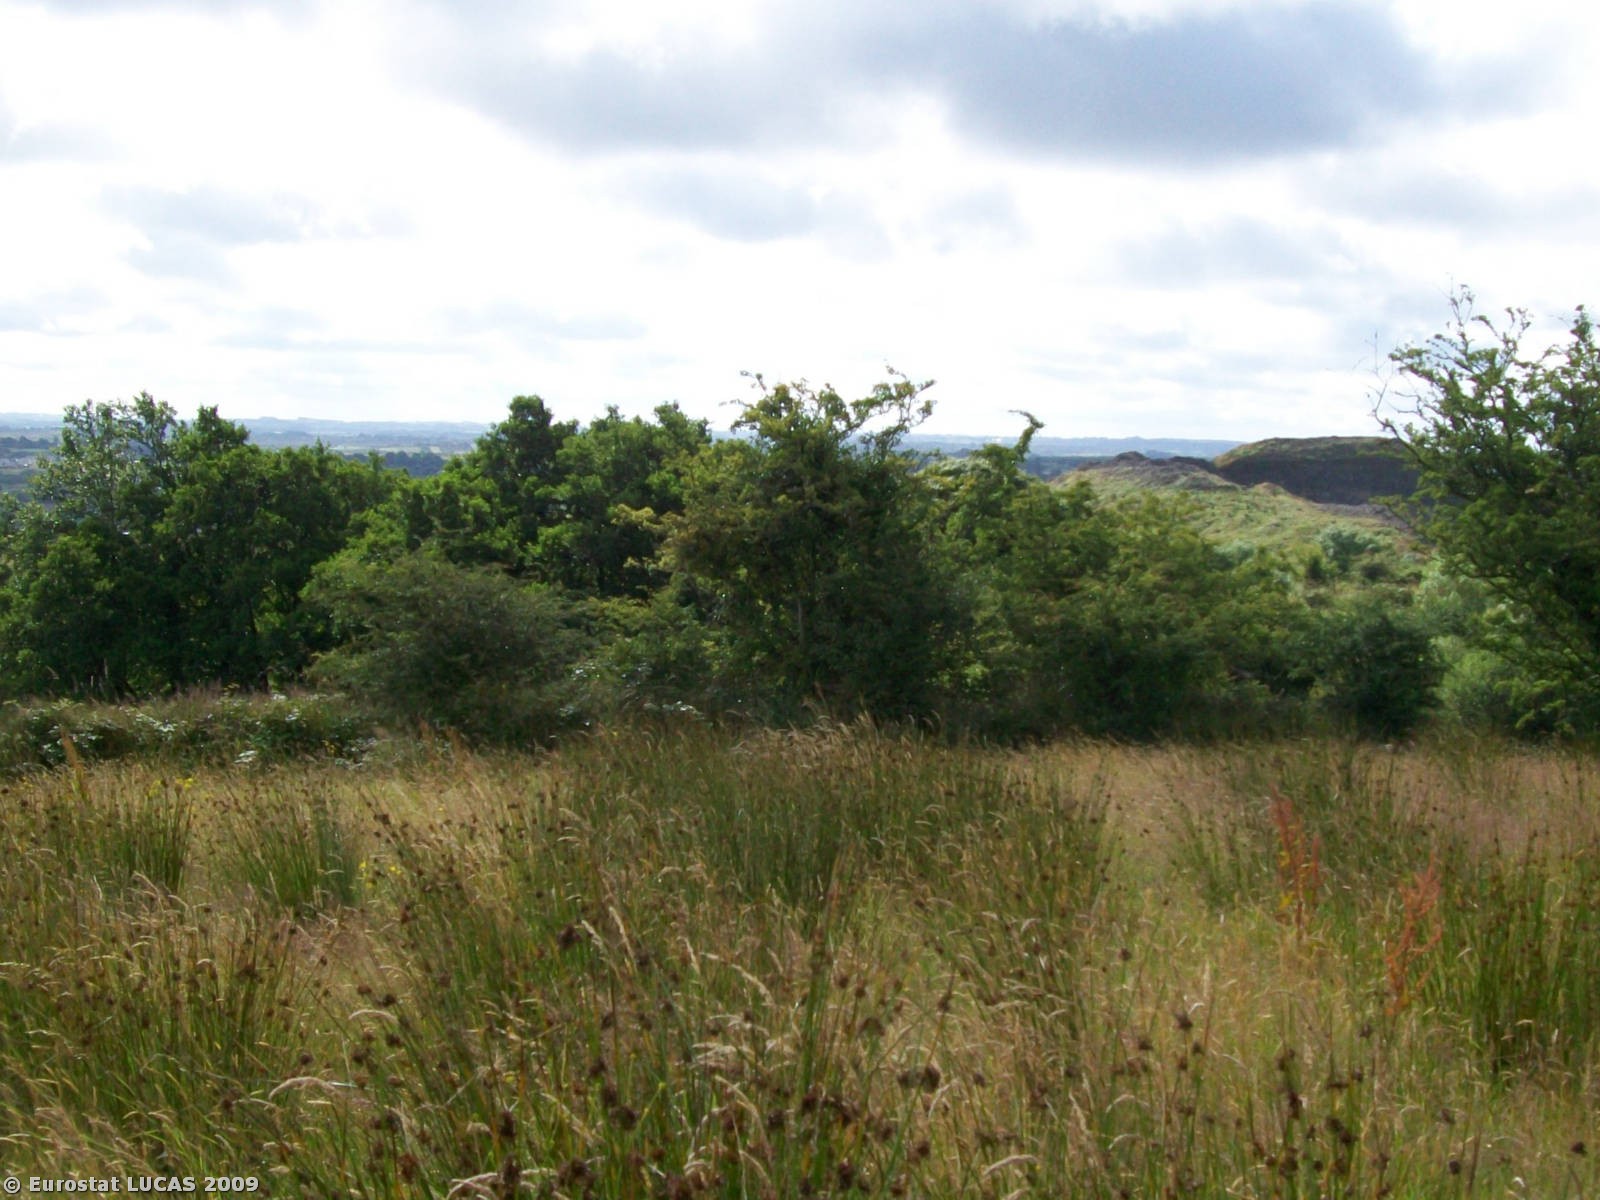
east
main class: Grassland
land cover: Grassland without tree/shrub cover
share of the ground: > 75 %
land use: Agriculture (excluding fallow land and kitchen gardens)
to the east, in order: Grassland without tree/shrub cover; Abandoned hedges; Grassland without tree/shrub cover; Grassland with sparse tree/shrub cover; Grass margins; Paved roads, cycling and walking lanes; Grass margins; Managed hedges; Grassland without tree/shrub cover; Electric lines; Grassland without tree/shrub cover; Mixed woodland
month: July
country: IE
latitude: 53.8498
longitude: -9.0477
